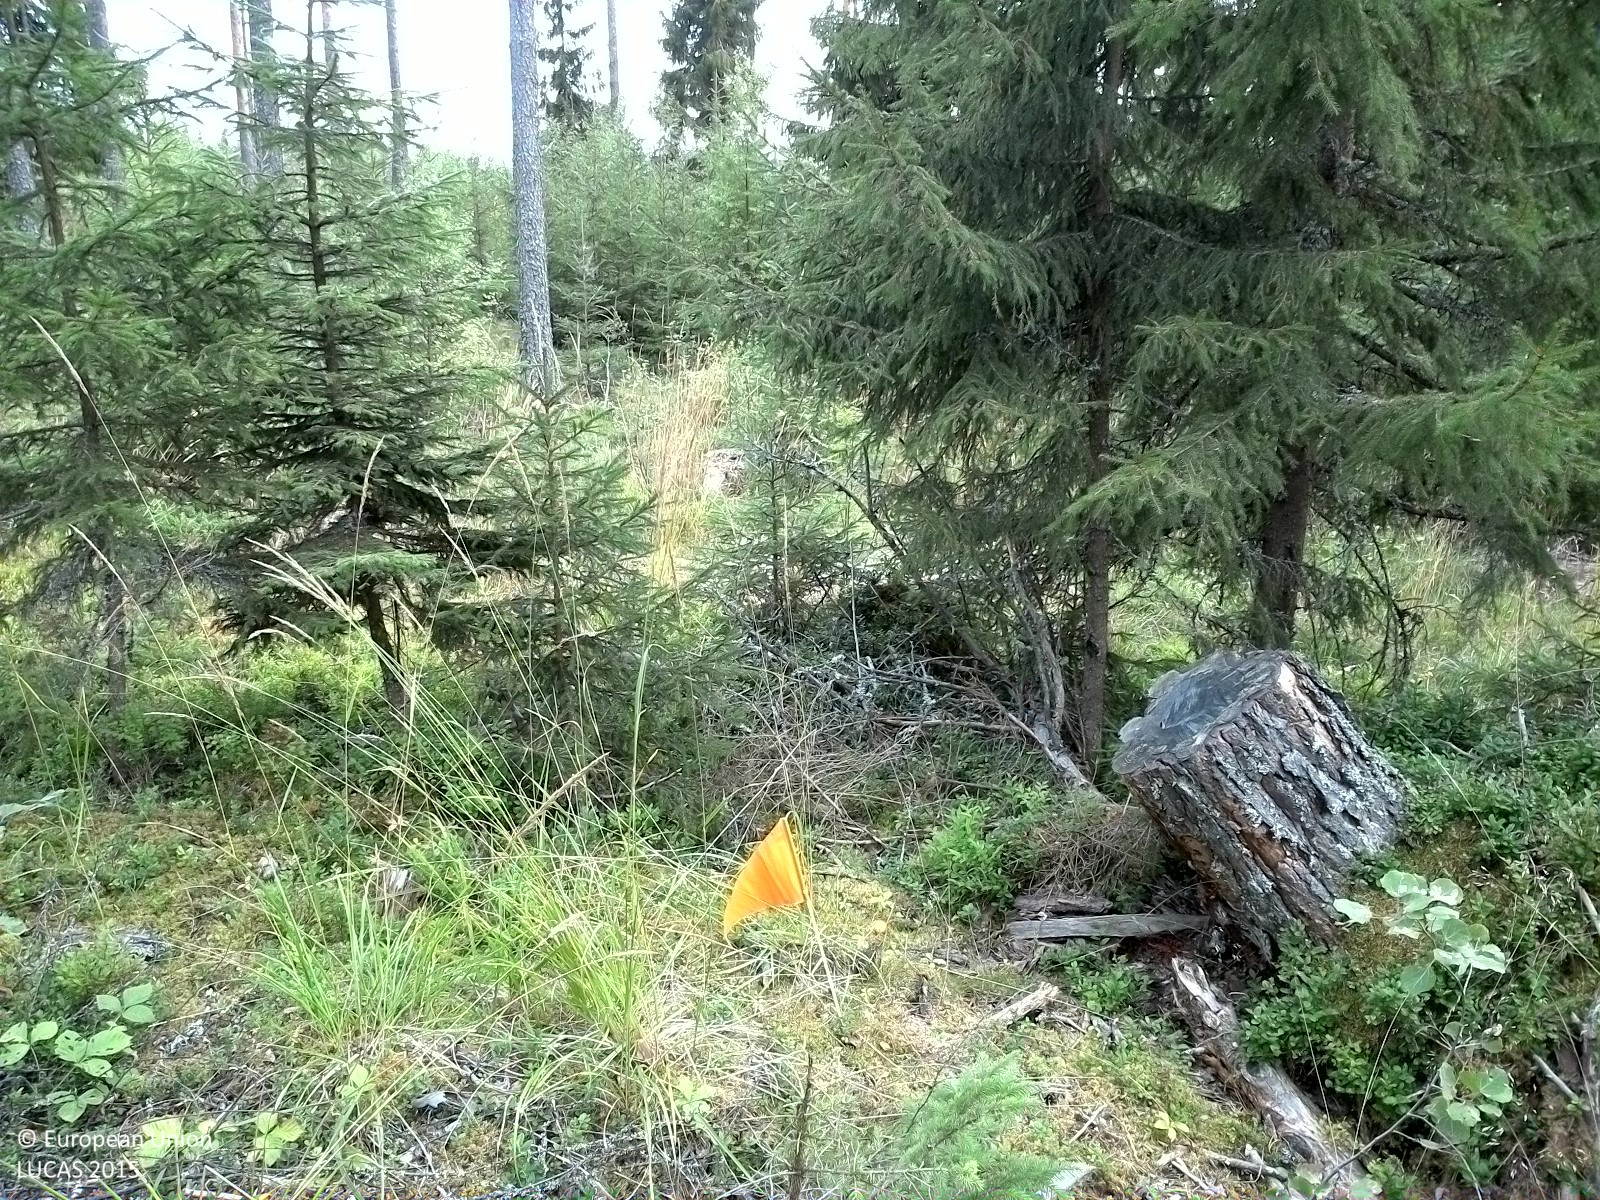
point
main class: Woodland
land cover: Pine dominated coniferous woodland
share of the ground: 50 - 75 %
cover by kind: coniferous forest trees 45 %, shrubs 20 %, herbaceous plants 20 %, broadleaved forest trees 10 %, lichens and mosses 5 %
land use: Forestry
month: August
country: SE
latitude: 62.4991
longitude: 16.2881
